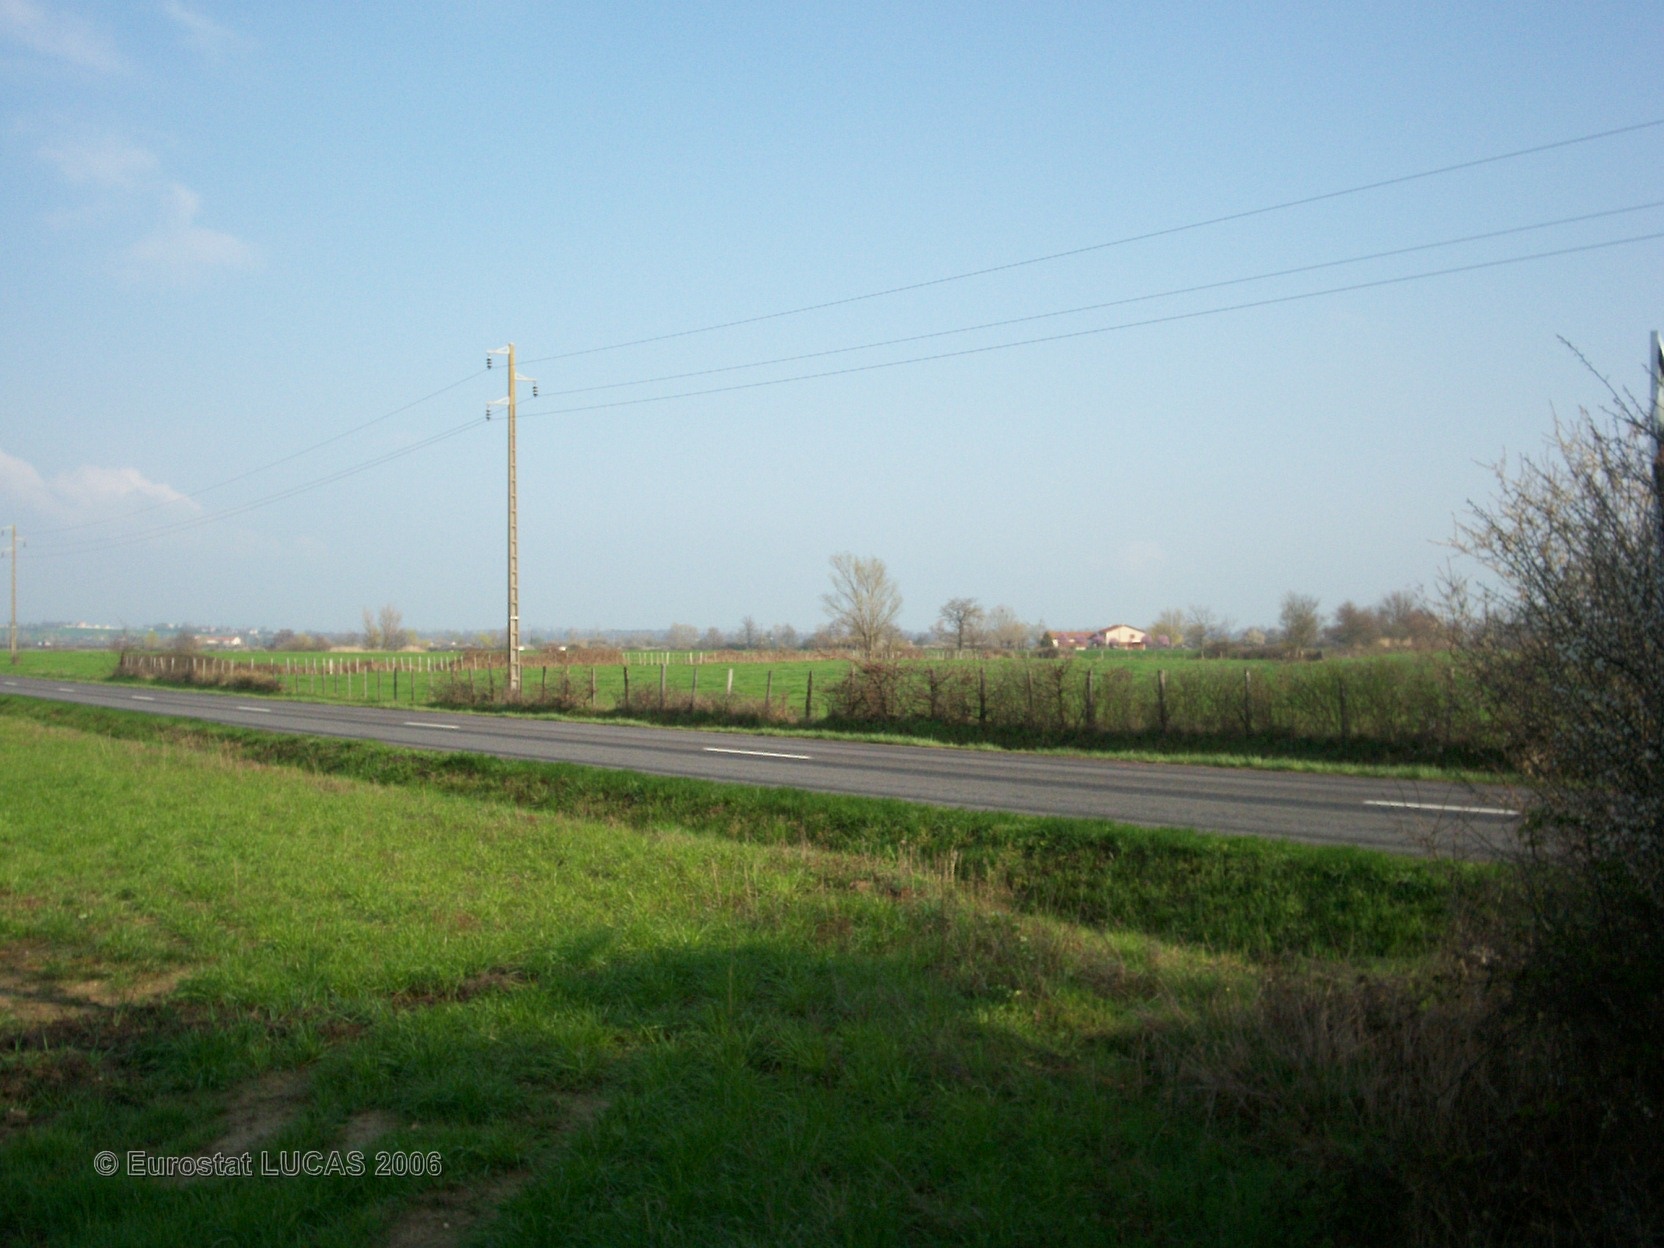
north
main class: Woodland
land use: Unused
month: April
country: FR
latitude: 45.5589
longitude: 4.1484
